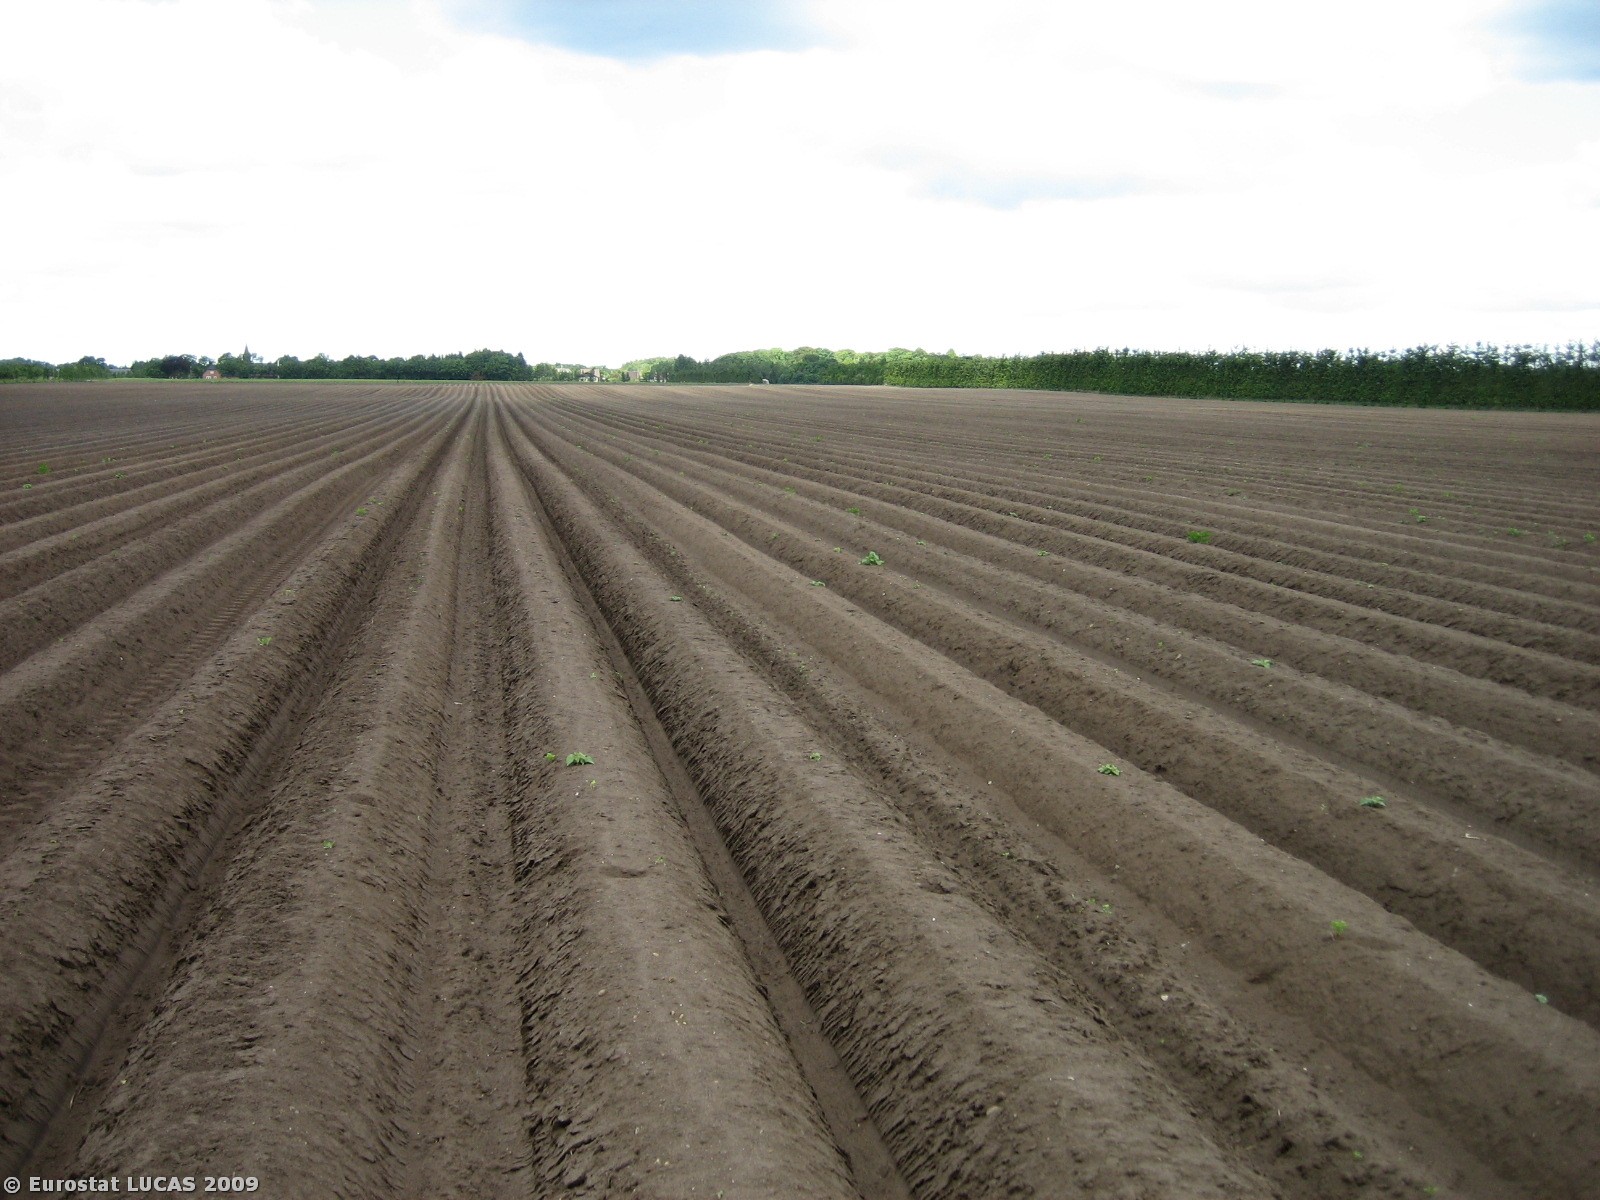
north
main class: Cropland
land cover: Potatoes
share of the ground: < 10 %
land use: Agriculture (excluding fallow land and kitchen gardens)
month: June
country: DK
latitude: 56.0241
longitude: 9.3109
